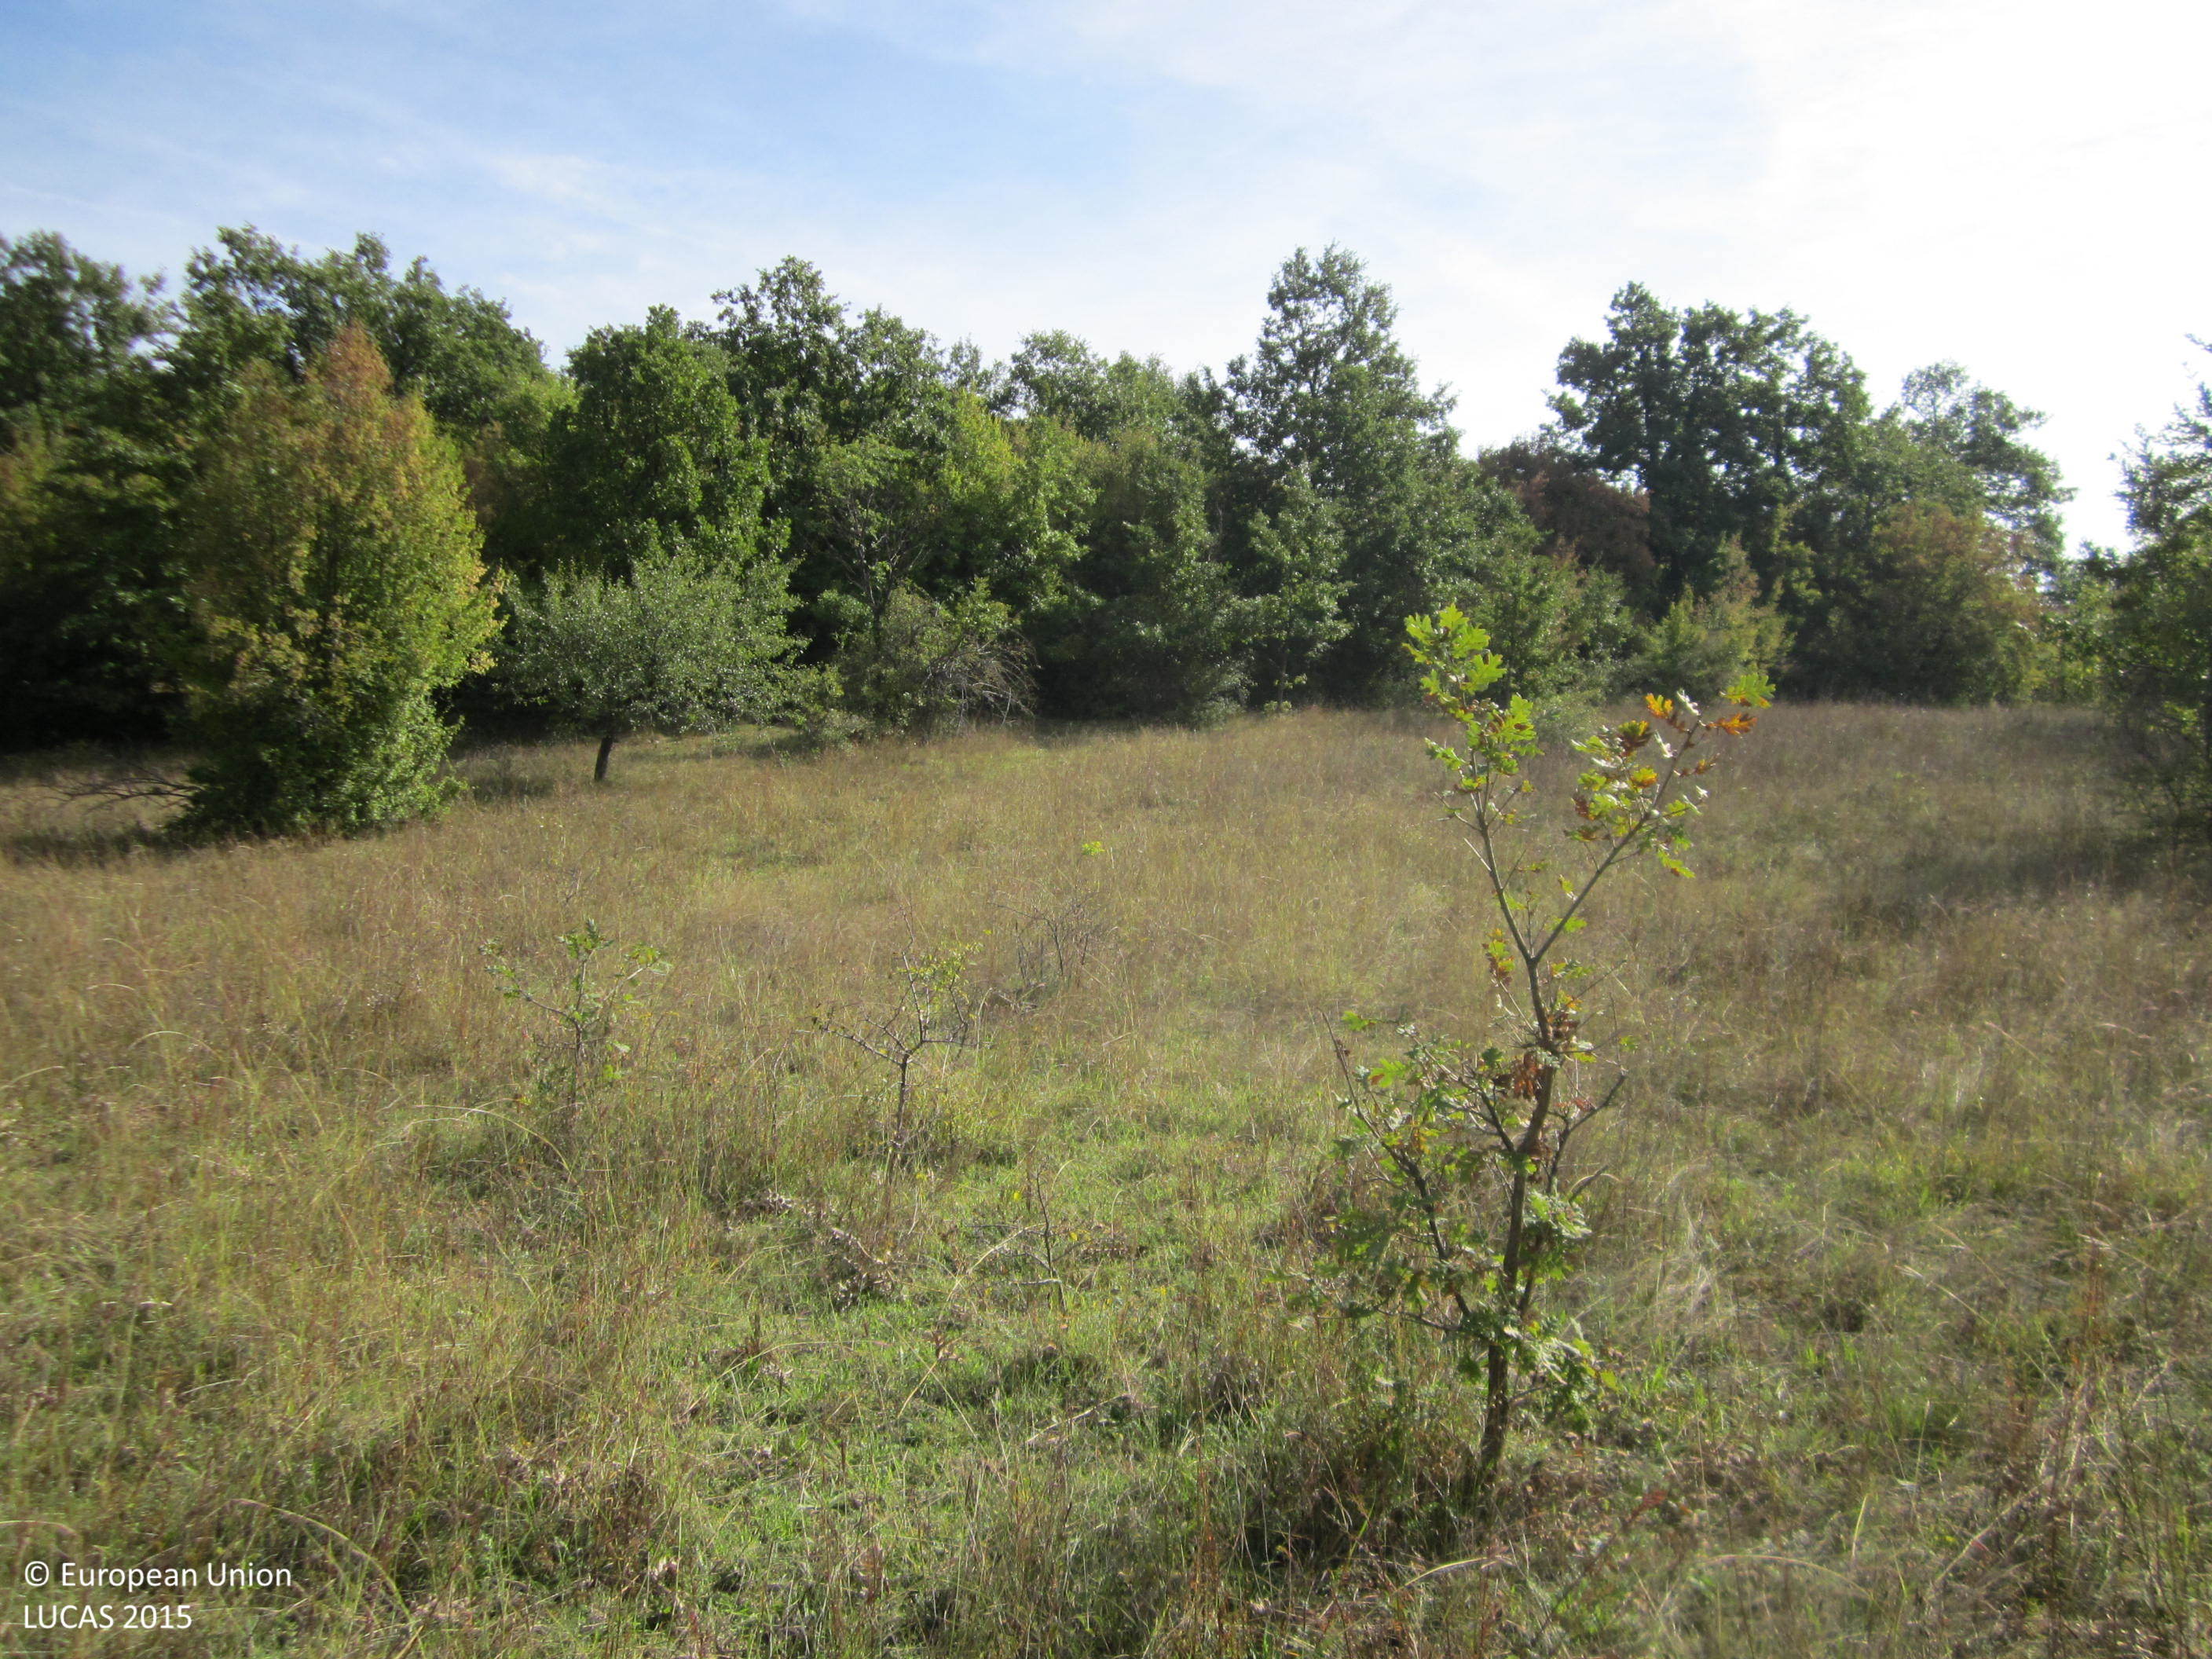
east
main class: Shrubland
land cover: Shrubland with sparse tree cover
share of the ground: 25 - 50 %
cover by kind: herbaceous plants 55 %, shrubs 40 %, broadleaved forest trees 5 %
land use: Semi-natural and natural areas not in use
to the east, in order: Shrubland with sparse tree cover; Grassland with sparse tree/shrub cover; Broadleaved woodland; Tracks; Grassland with sparse tree/shrub cover; Tracks; Grassland with sparse tree/shrub cover; Broadleaved woodland; Grassland without tree/shrub cover
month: October
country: BG
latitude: 42.8919
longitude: 26.8200
